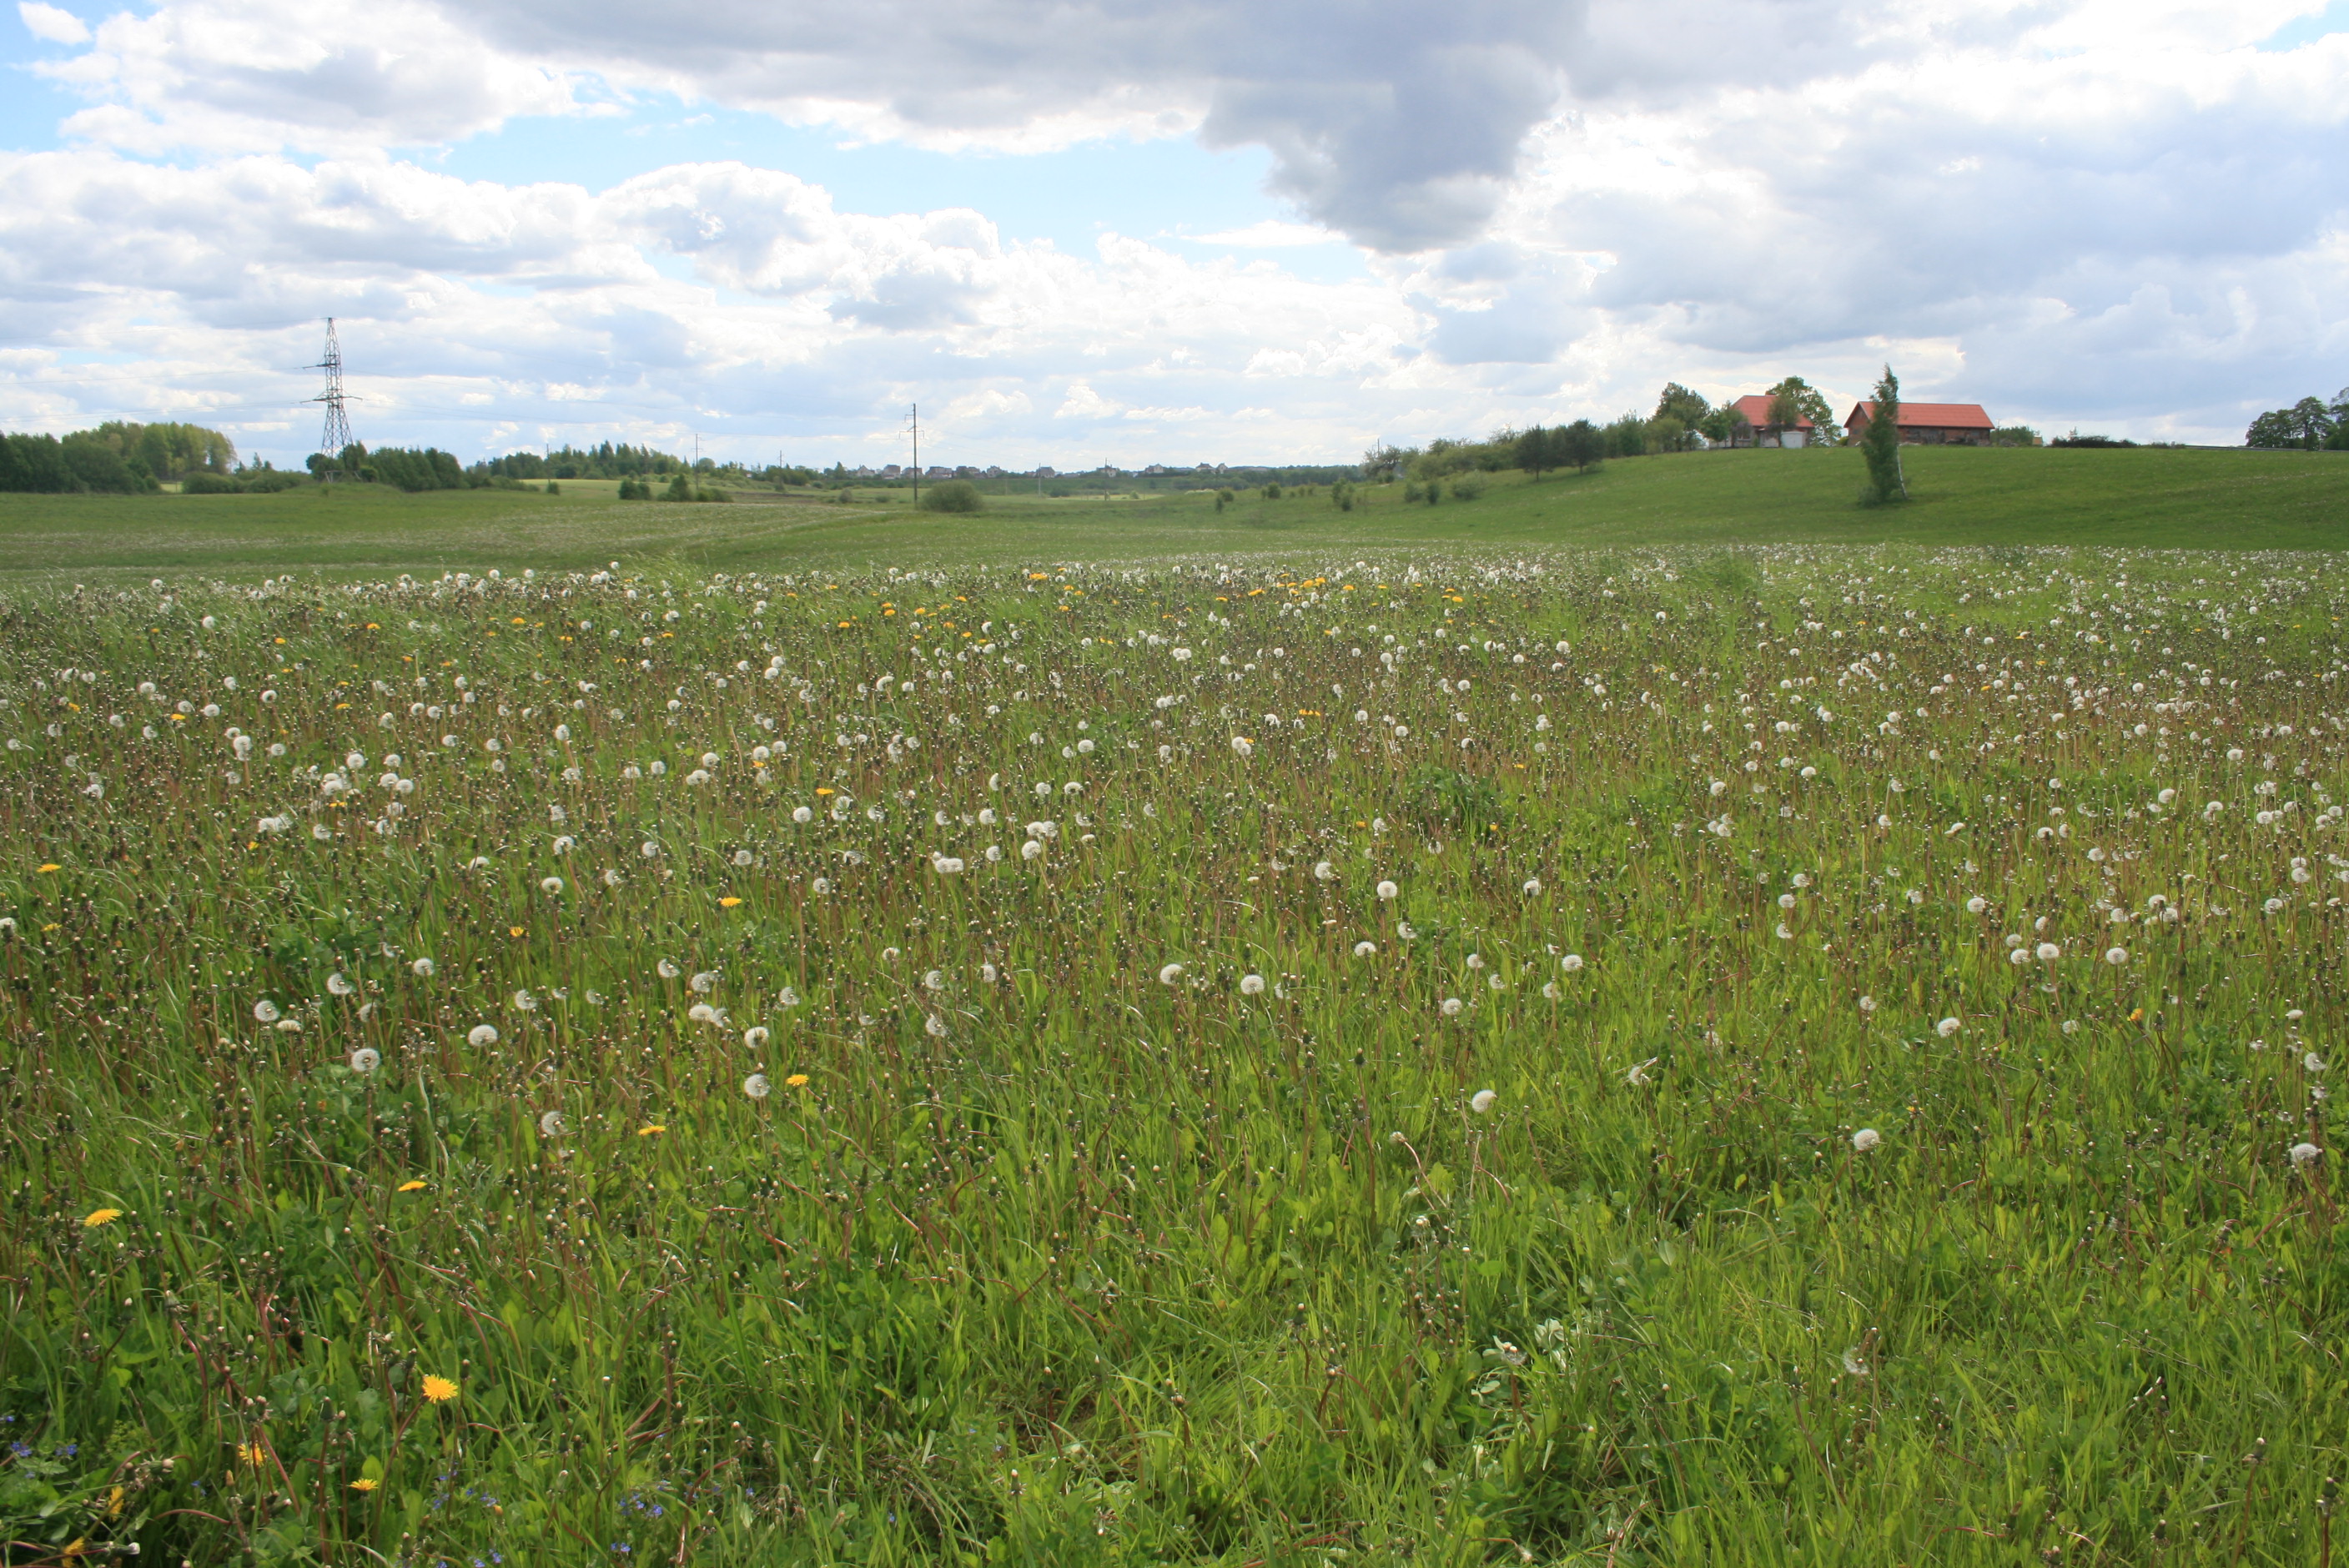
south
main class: Grassland
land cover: Grassland without tree/shrub cover
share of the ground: > 75 %
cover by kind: herbaceous plants 100 %
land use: Agriculture (excluding fallow land and kitchen gardens)
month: May
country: LT
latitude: 56.0011
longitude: 22.2255
